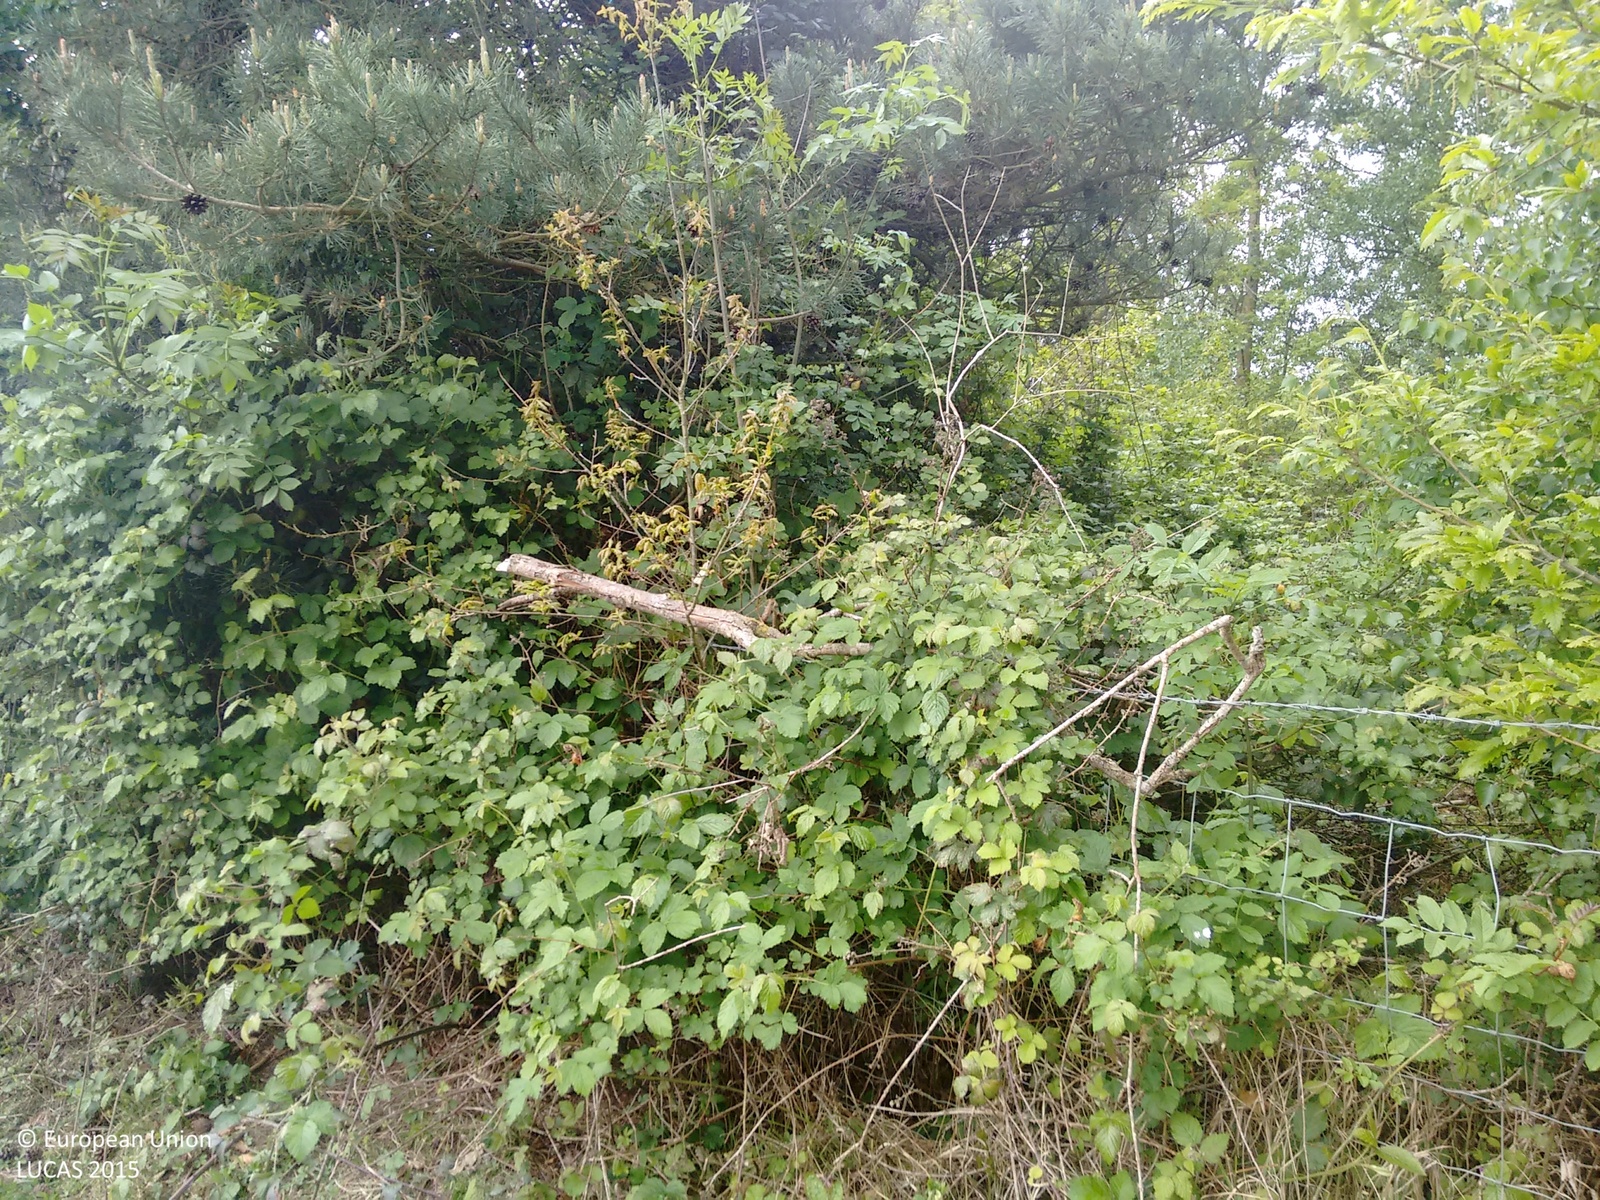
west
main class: Woodland
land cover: Broadleaved woodland
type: mesophytic deciduous forest
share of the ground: > 75 %
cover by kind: broadleaved forest trees 80 %, shrubs 20 %
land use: Semi-natural and natural areas not in use
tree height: > 5 m
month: May
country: GB
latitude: 51.2030
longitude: 0.7717
